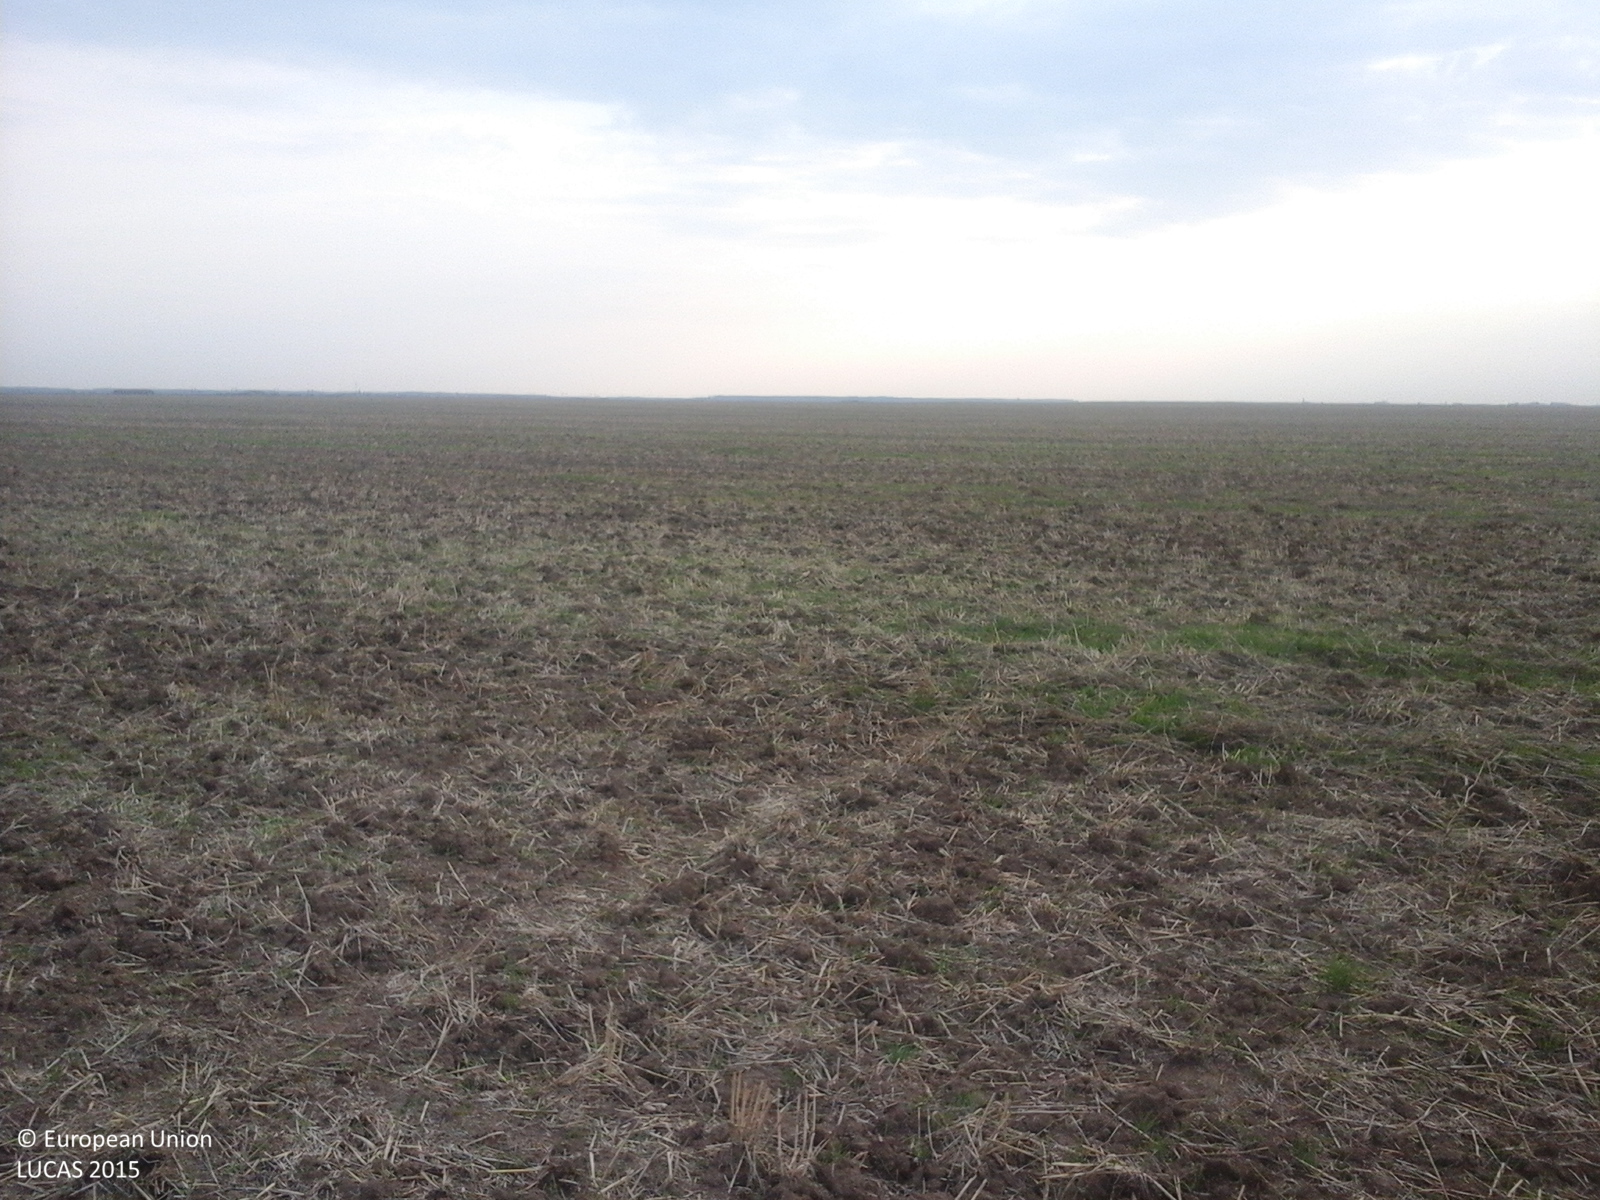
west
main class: Cropland
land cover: Durum wheat
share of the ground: < 10 %
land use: Agriculture (excluding fallow land and kitchen gardens)
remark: Harvested field
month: August
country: RO
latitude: 46.1832
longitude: 21.5015
